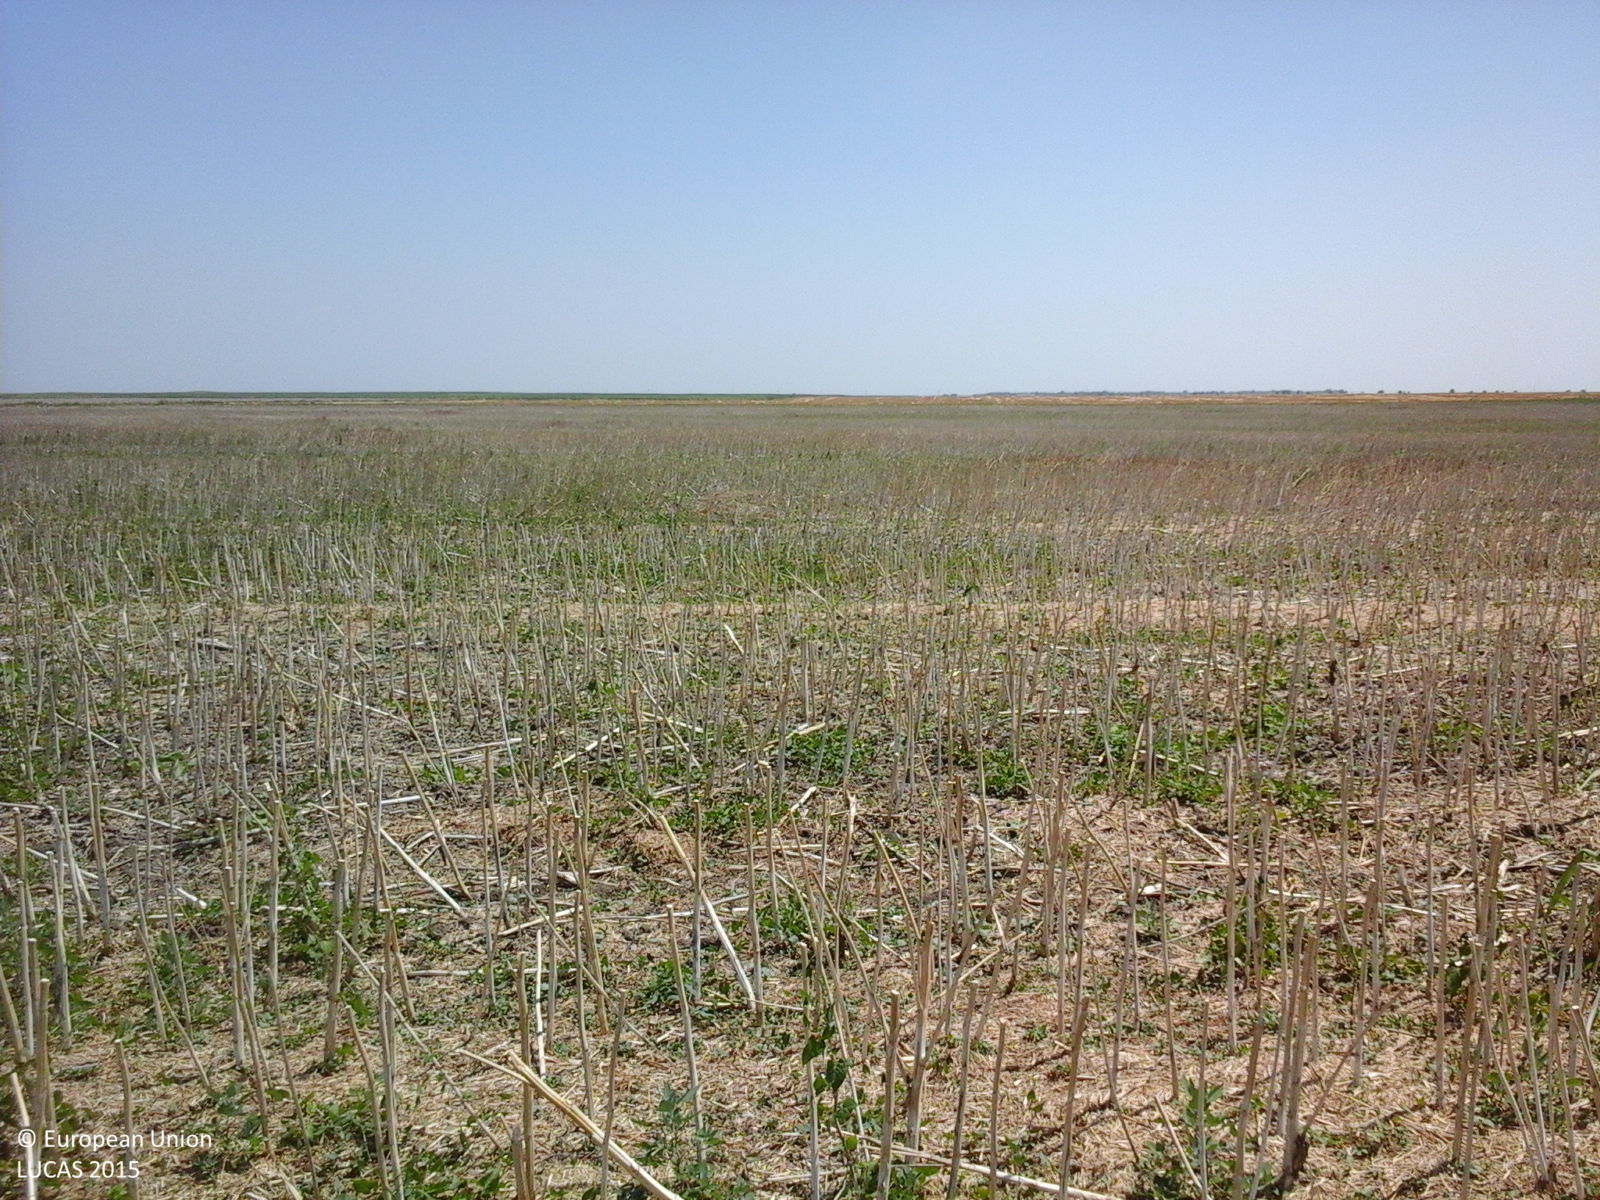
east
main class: Cropland
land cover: Rape and turnip rape
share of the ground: < 10 %
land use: Agriculture (excluding fallow land and kitchen gardens)
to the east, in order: Rape and turnip rape
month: July
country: RO
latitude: 44.4838
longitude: 27.0929
